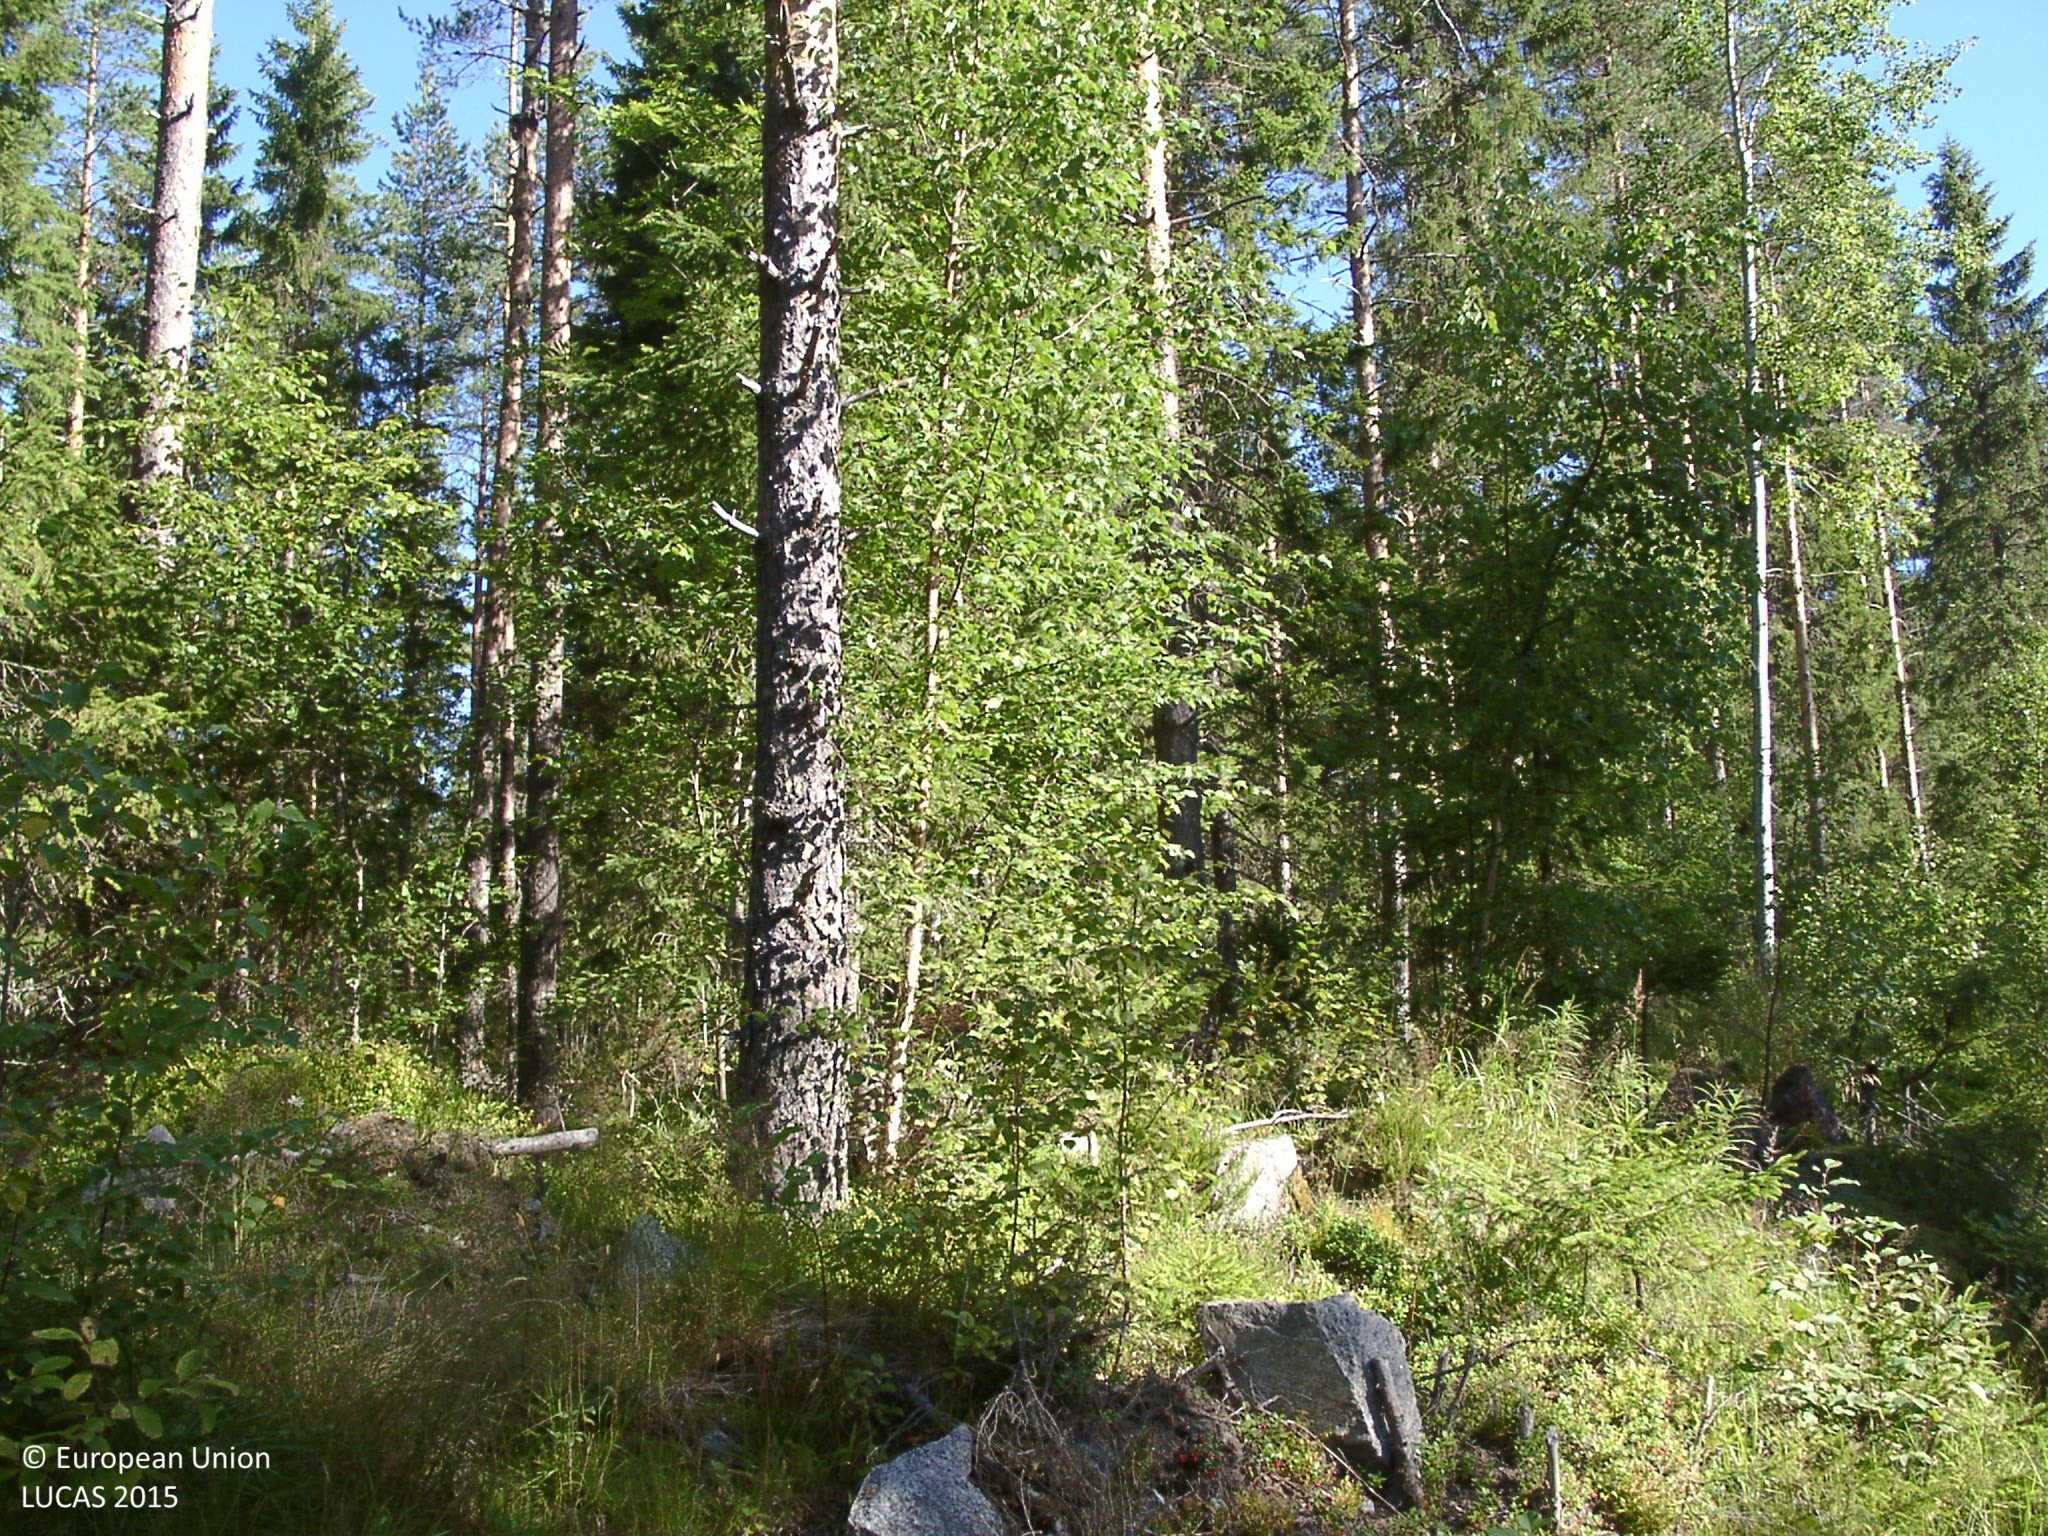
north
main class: Woodland
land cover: Other mixed woodland
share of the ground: 50 - 75 %
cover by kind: coniferous forest trees 45 %, shrubs 25 %, broadleaved forest trees 20 %, herbaceous plants 10 %
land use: Forestry
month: August
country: FI
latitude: 62.3683
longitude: 25.2008
